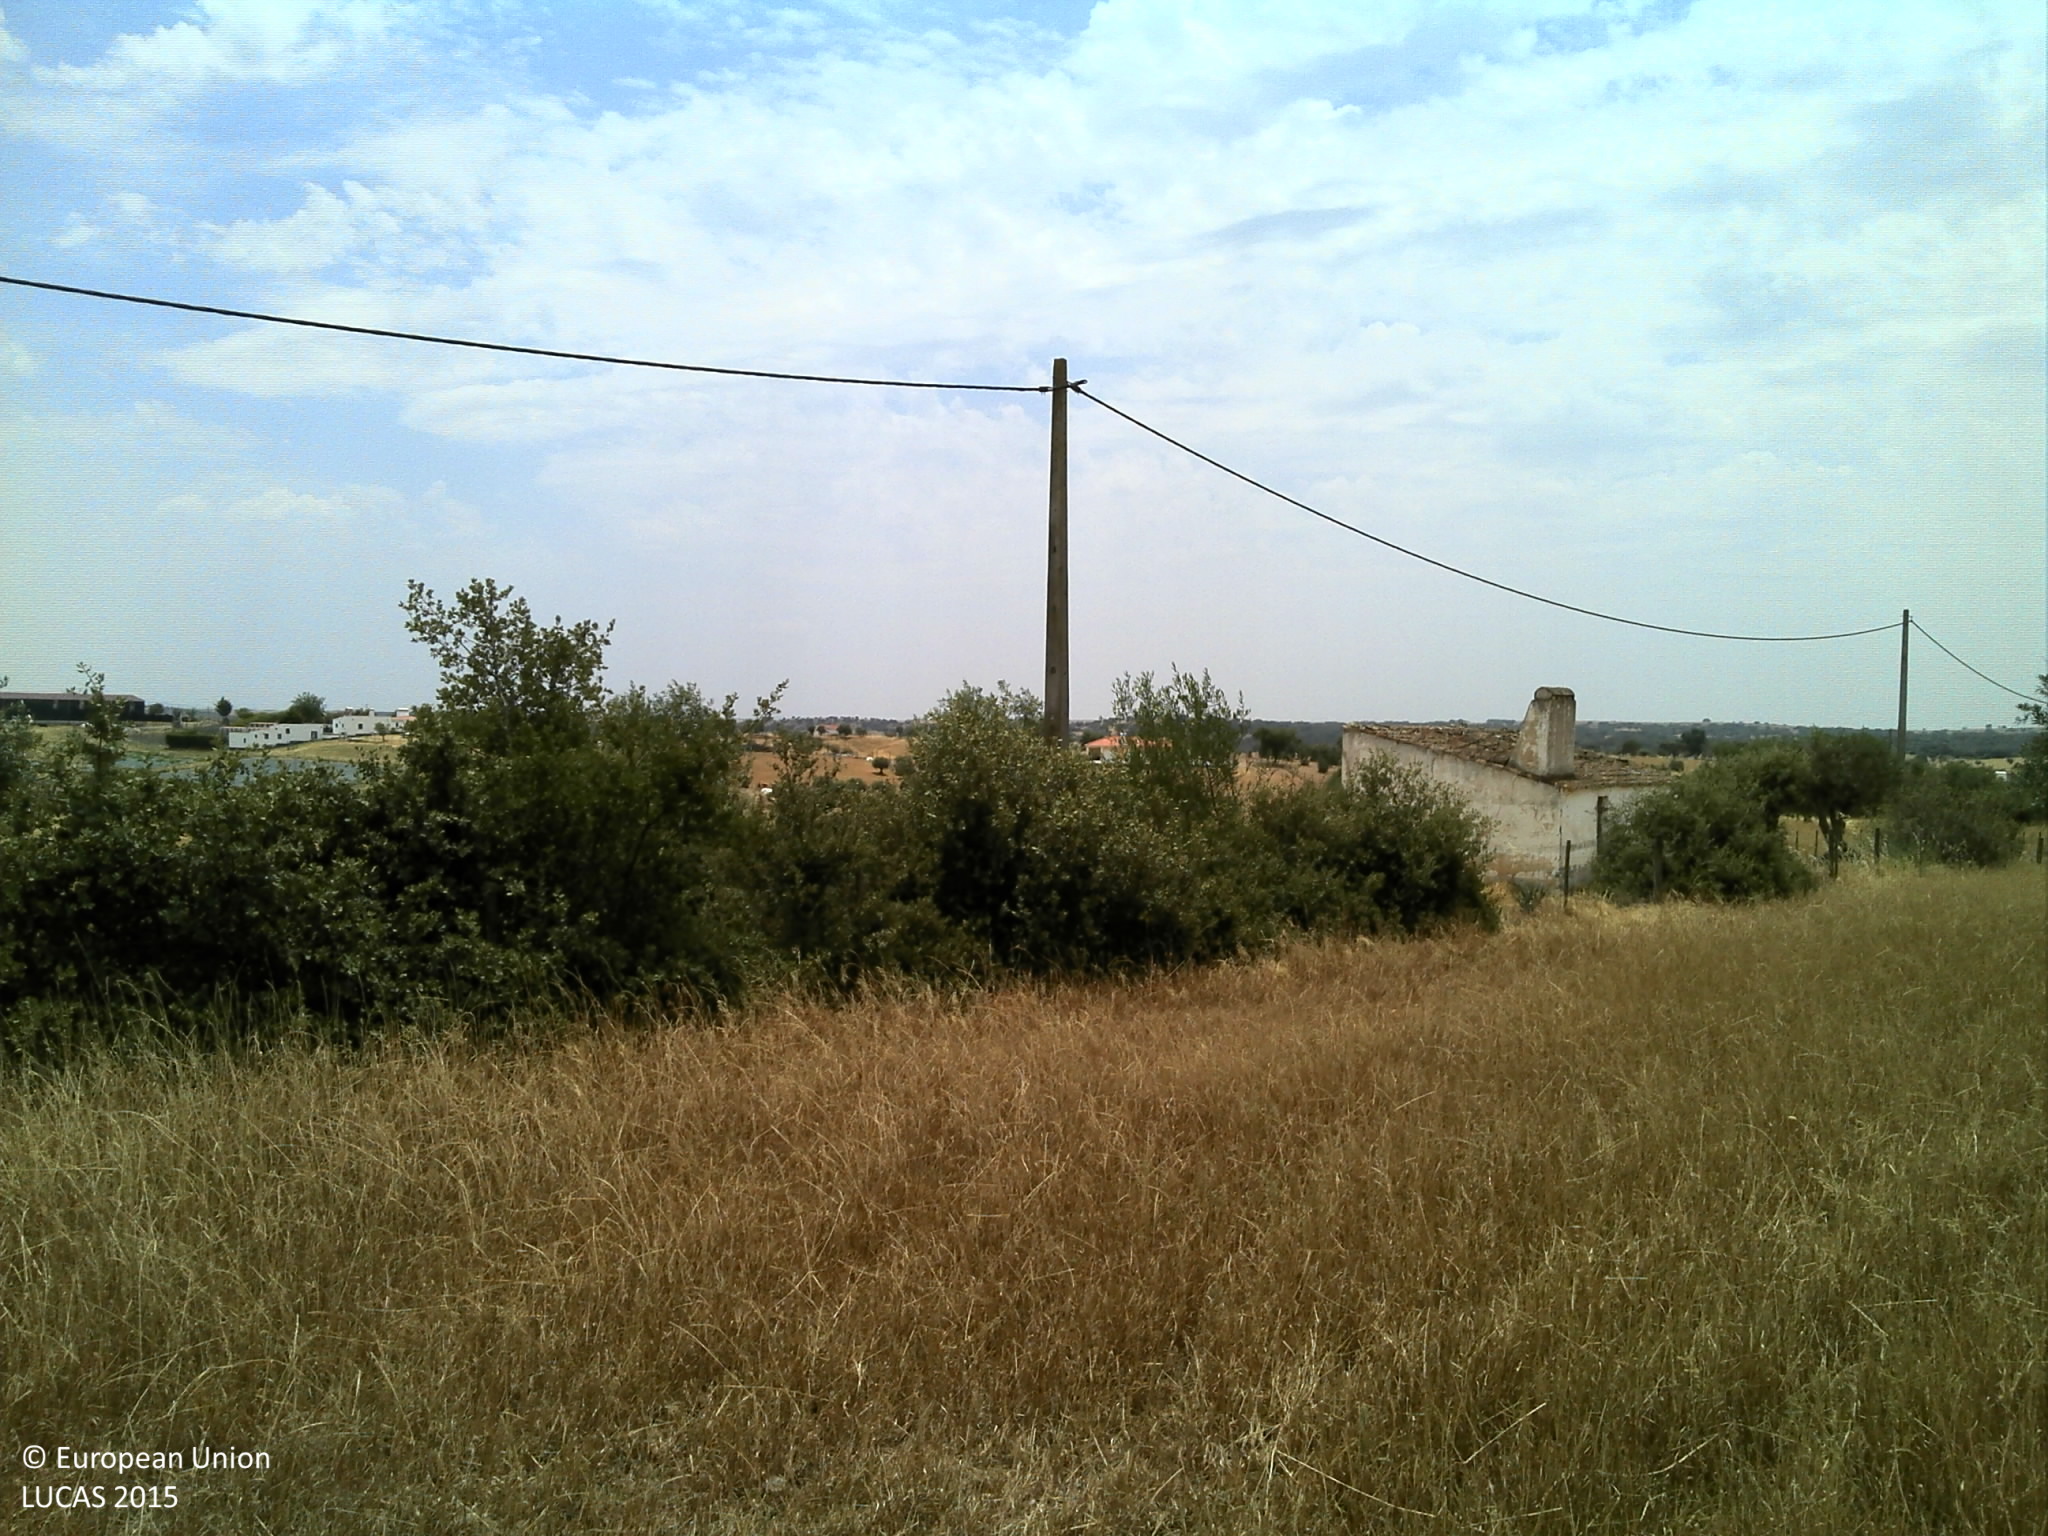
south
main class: Cropland
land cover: Olive groves
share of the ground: 10 - 25 %
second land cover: Mixed cereals for fodder
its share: 25 - 50 %
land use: Agriculture (excluding fallow land and kitchen gardens)
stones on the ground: < 10 %
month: June
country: PT
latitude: 38.5749
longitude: -7.7702
